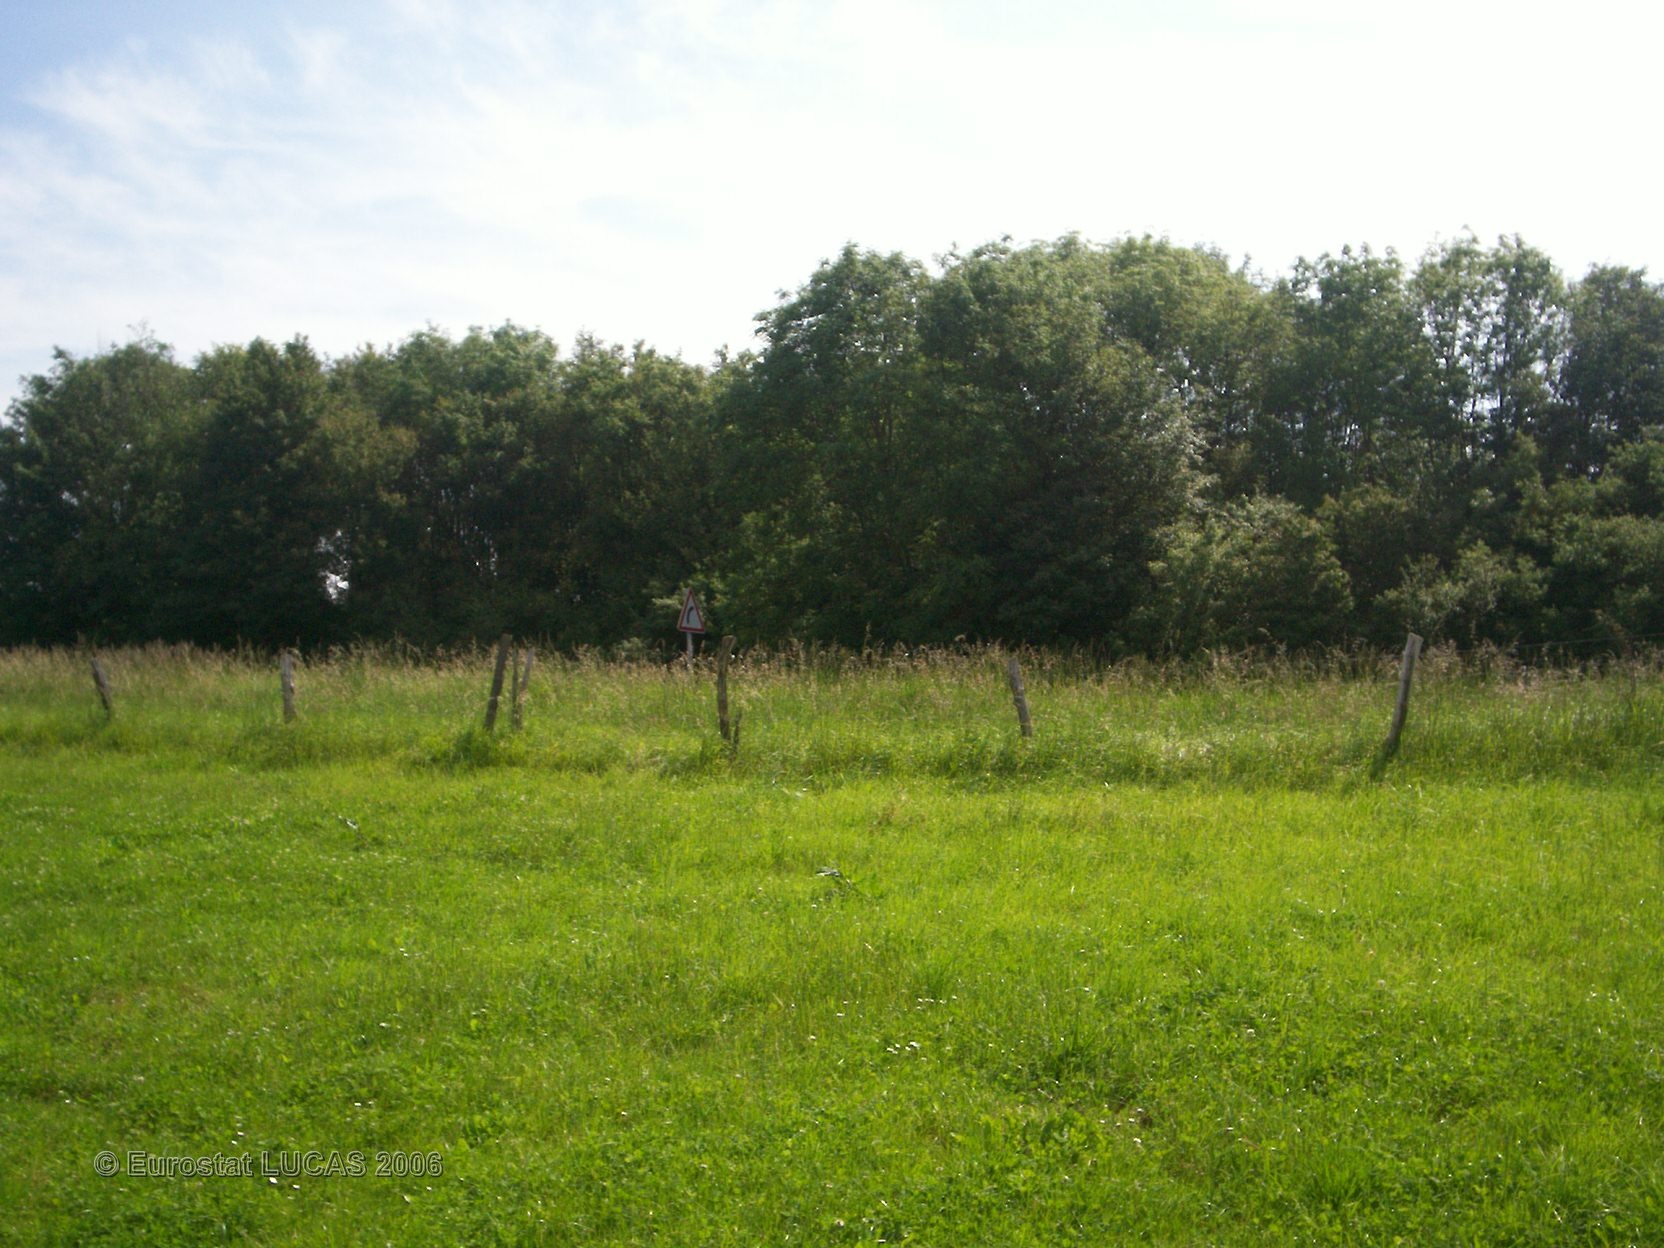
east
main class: Grassland
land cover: Grassland without tree/shrub cover
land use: Agriculture (excluding fallow land and kitchen gardens)
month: June
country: FR
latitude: 49.5710
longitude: 2.7016
